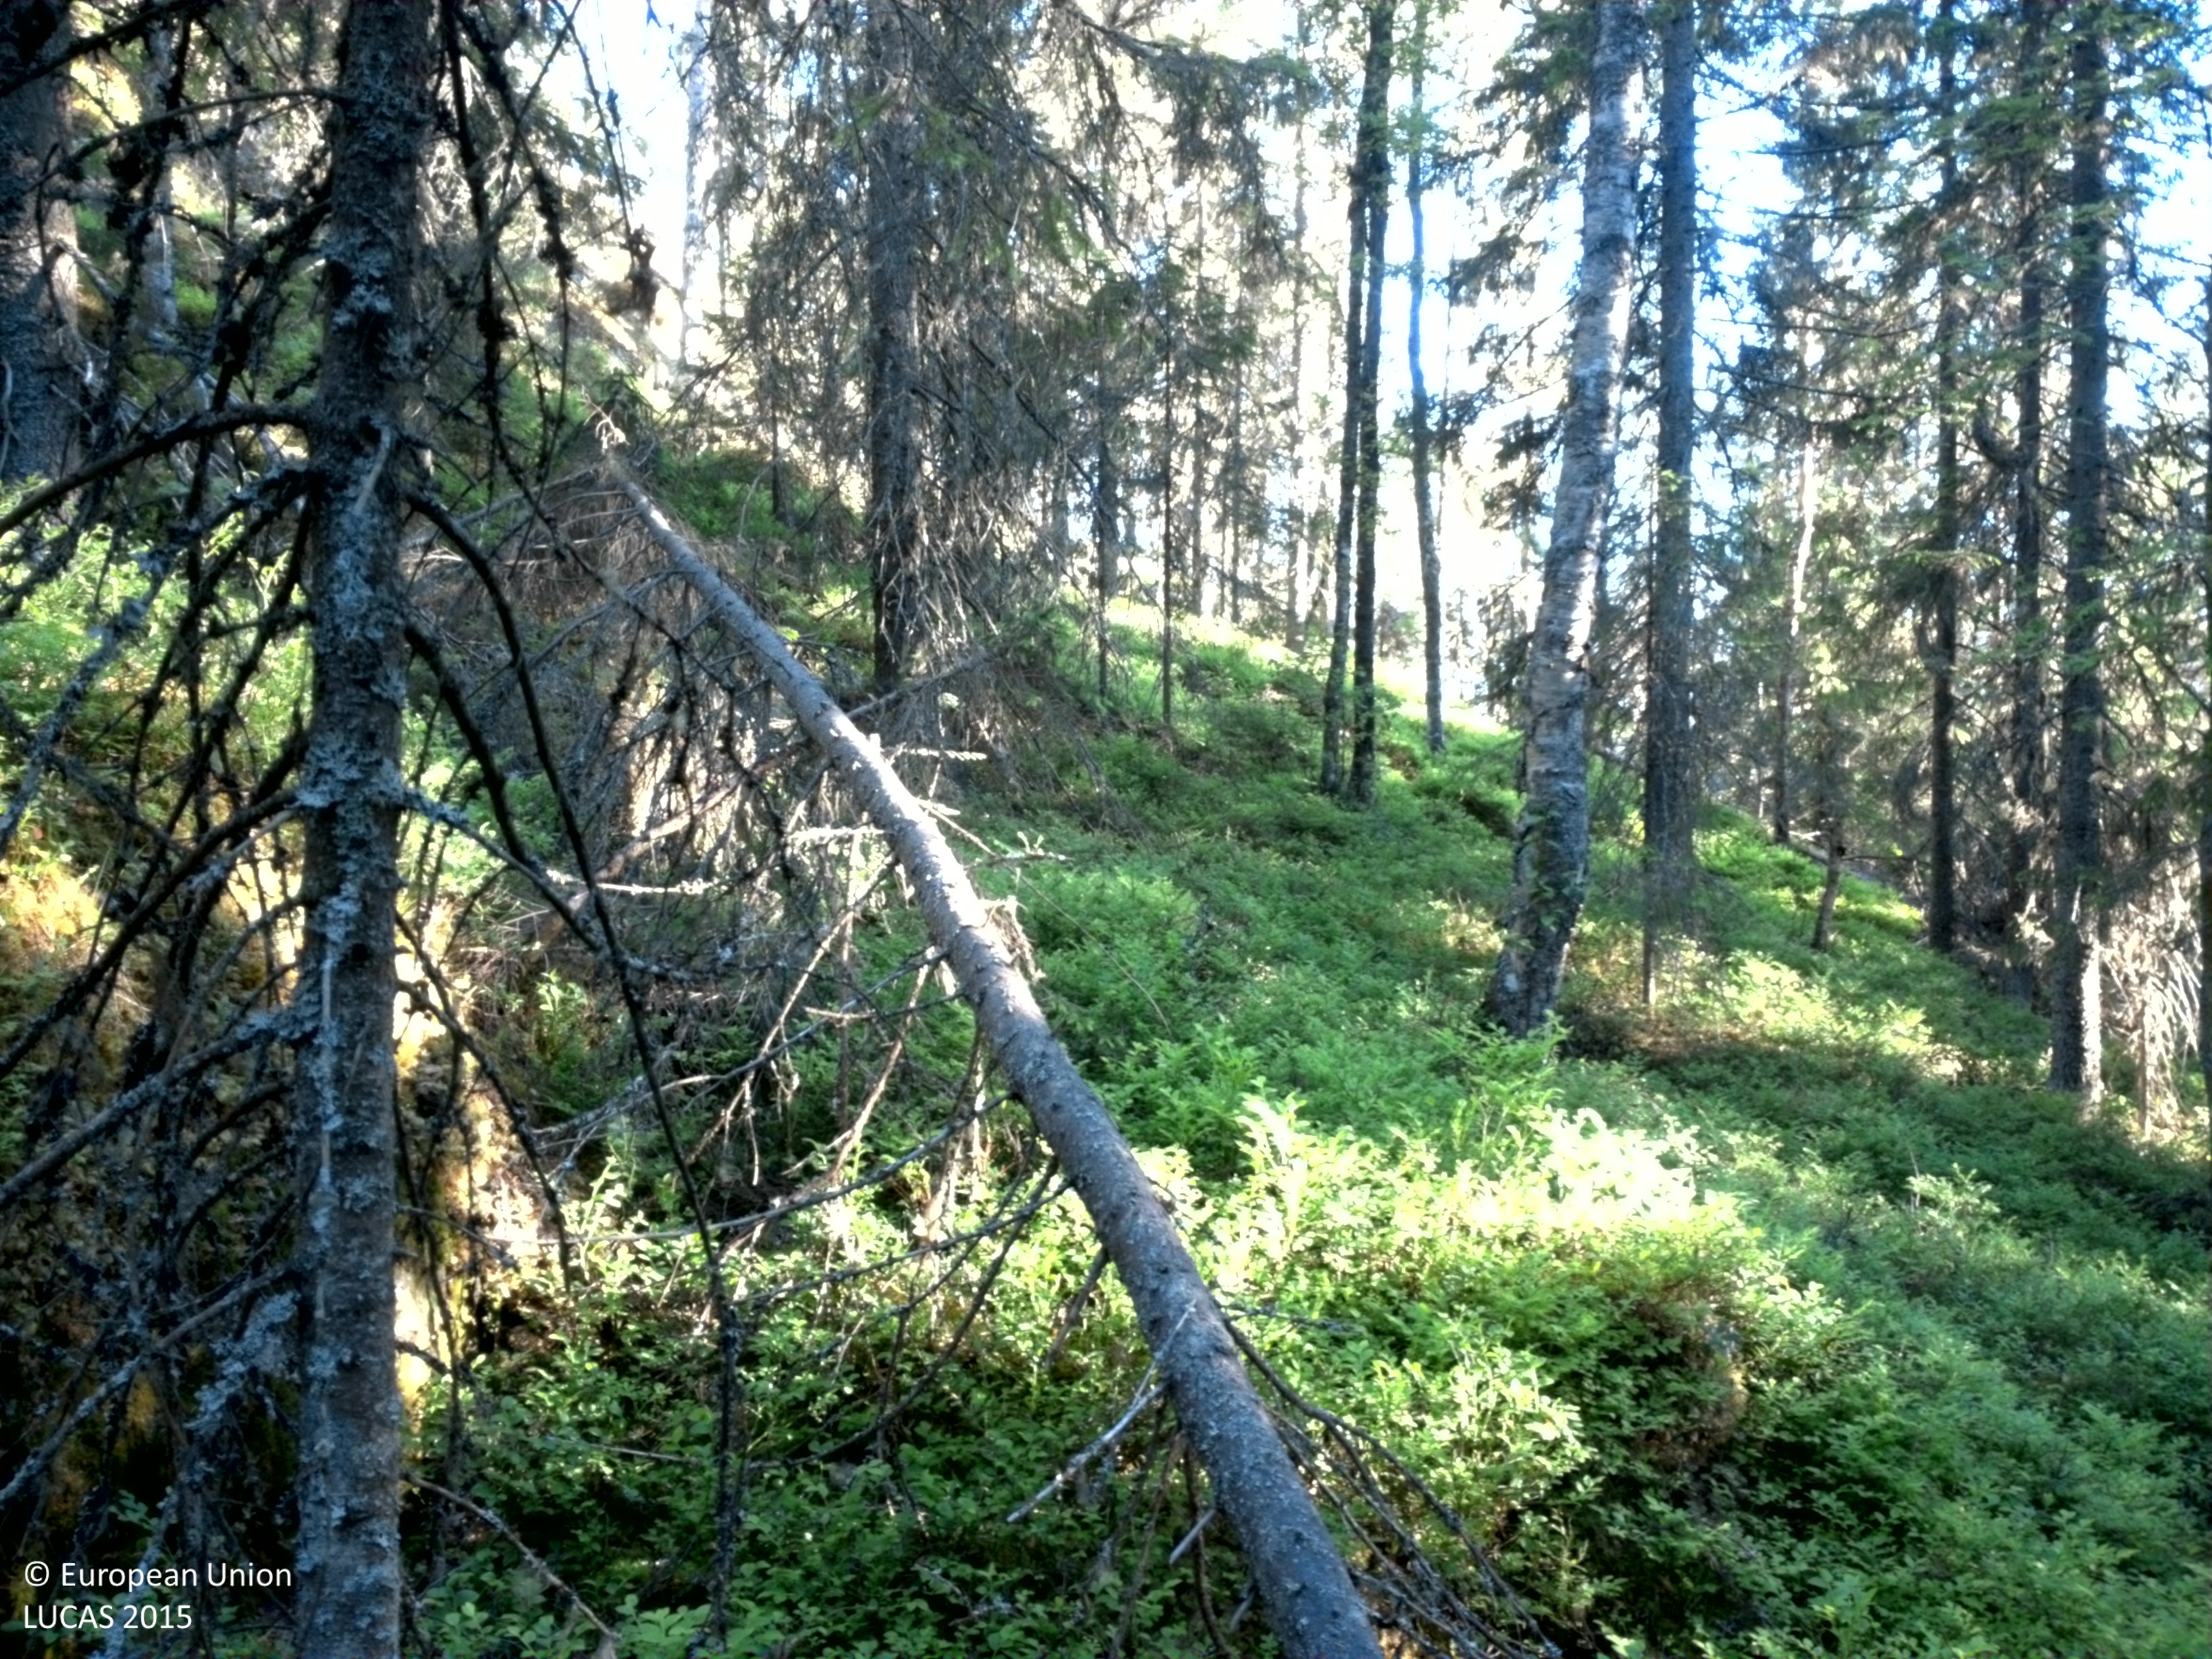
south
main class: Woodland
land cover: Spruce dominated coniferous woodland
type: boreal forest
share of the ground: 50 - 75 %
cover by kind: coniferous forest trees 70 %, shrubs 25 %, lichens and mosses 5 %
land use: Forestry
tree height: > 5 m
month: June
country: SE
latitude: 64.2759
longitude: 20.6563
